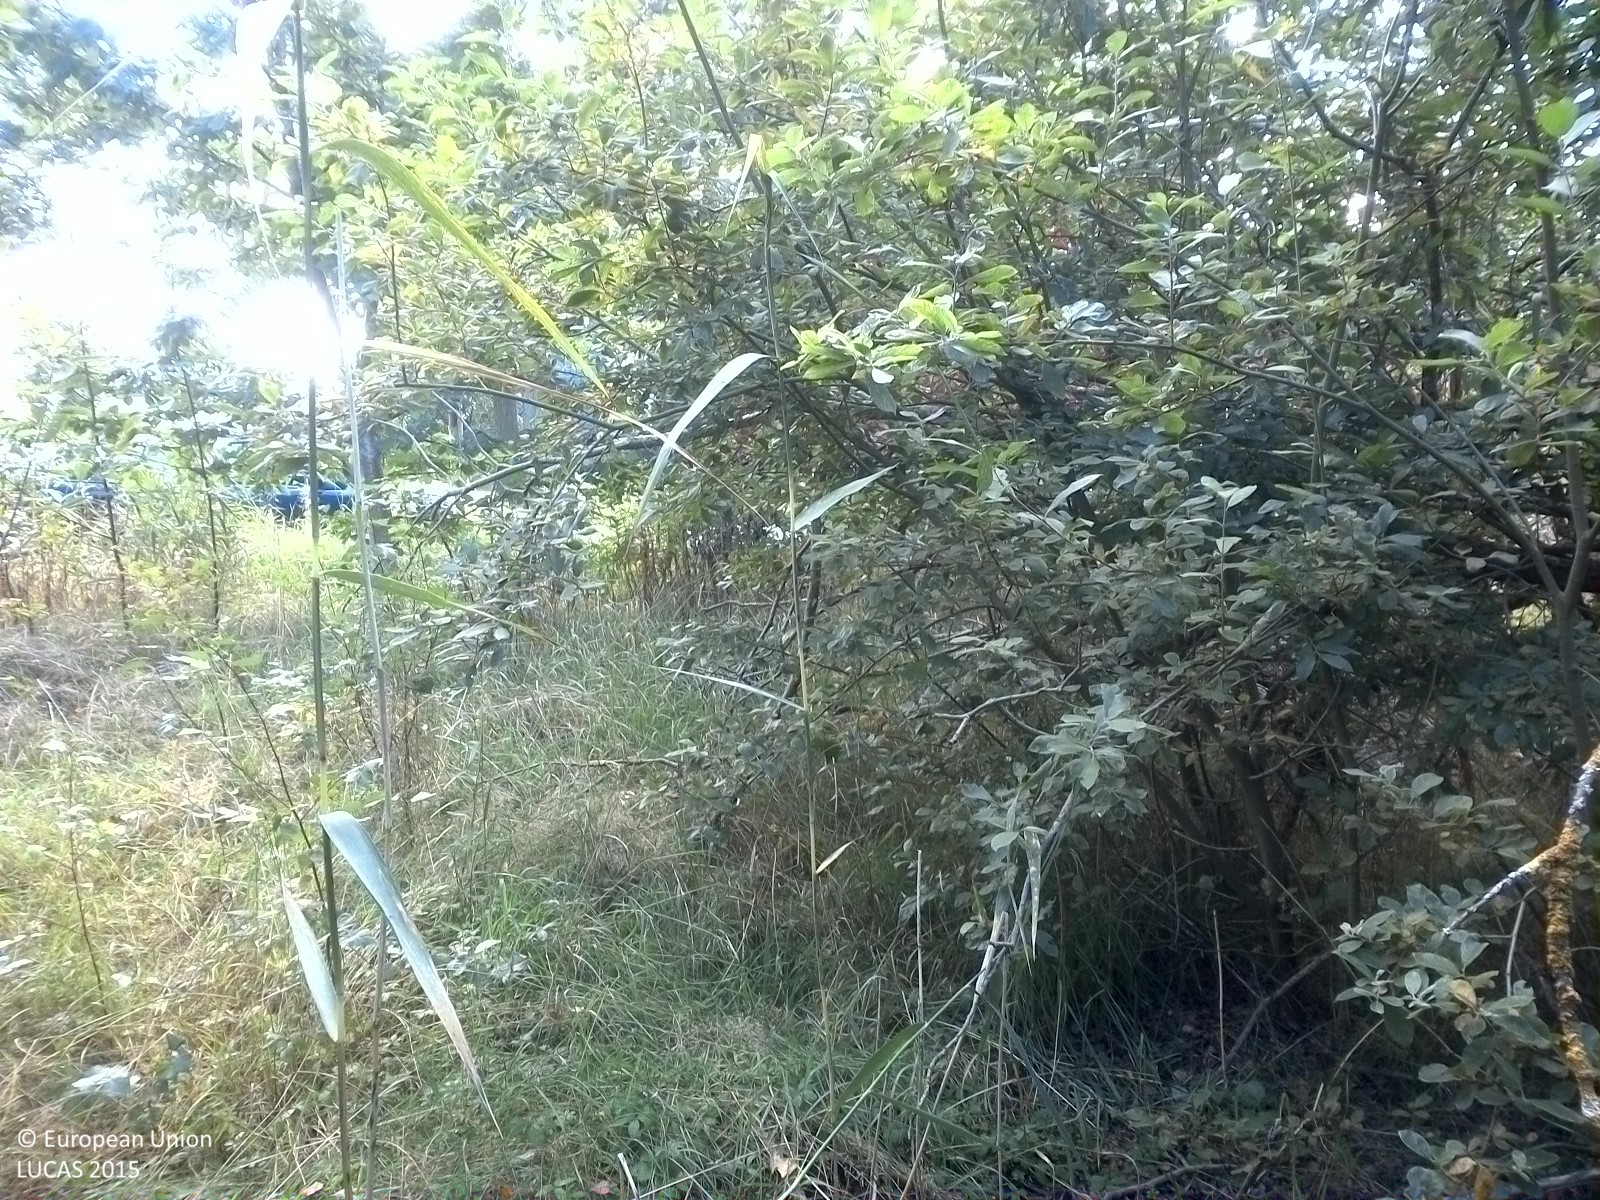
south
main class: Woodland
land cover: Broadleaved woodland
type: hemiboreal forest and nemoral coniferous forest and mixed broadleaved-coniferous forest
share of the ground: 50 - 75 %
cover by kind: broadleaved forest trees 60 %, herbaceous plants 20 %, shrubs 10 %, consolidated bare surface 10 %
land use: Semi-natural and natural areas not in use
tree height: > 5 m
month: September
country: SE
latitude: 58.5996
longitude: 16.2071
